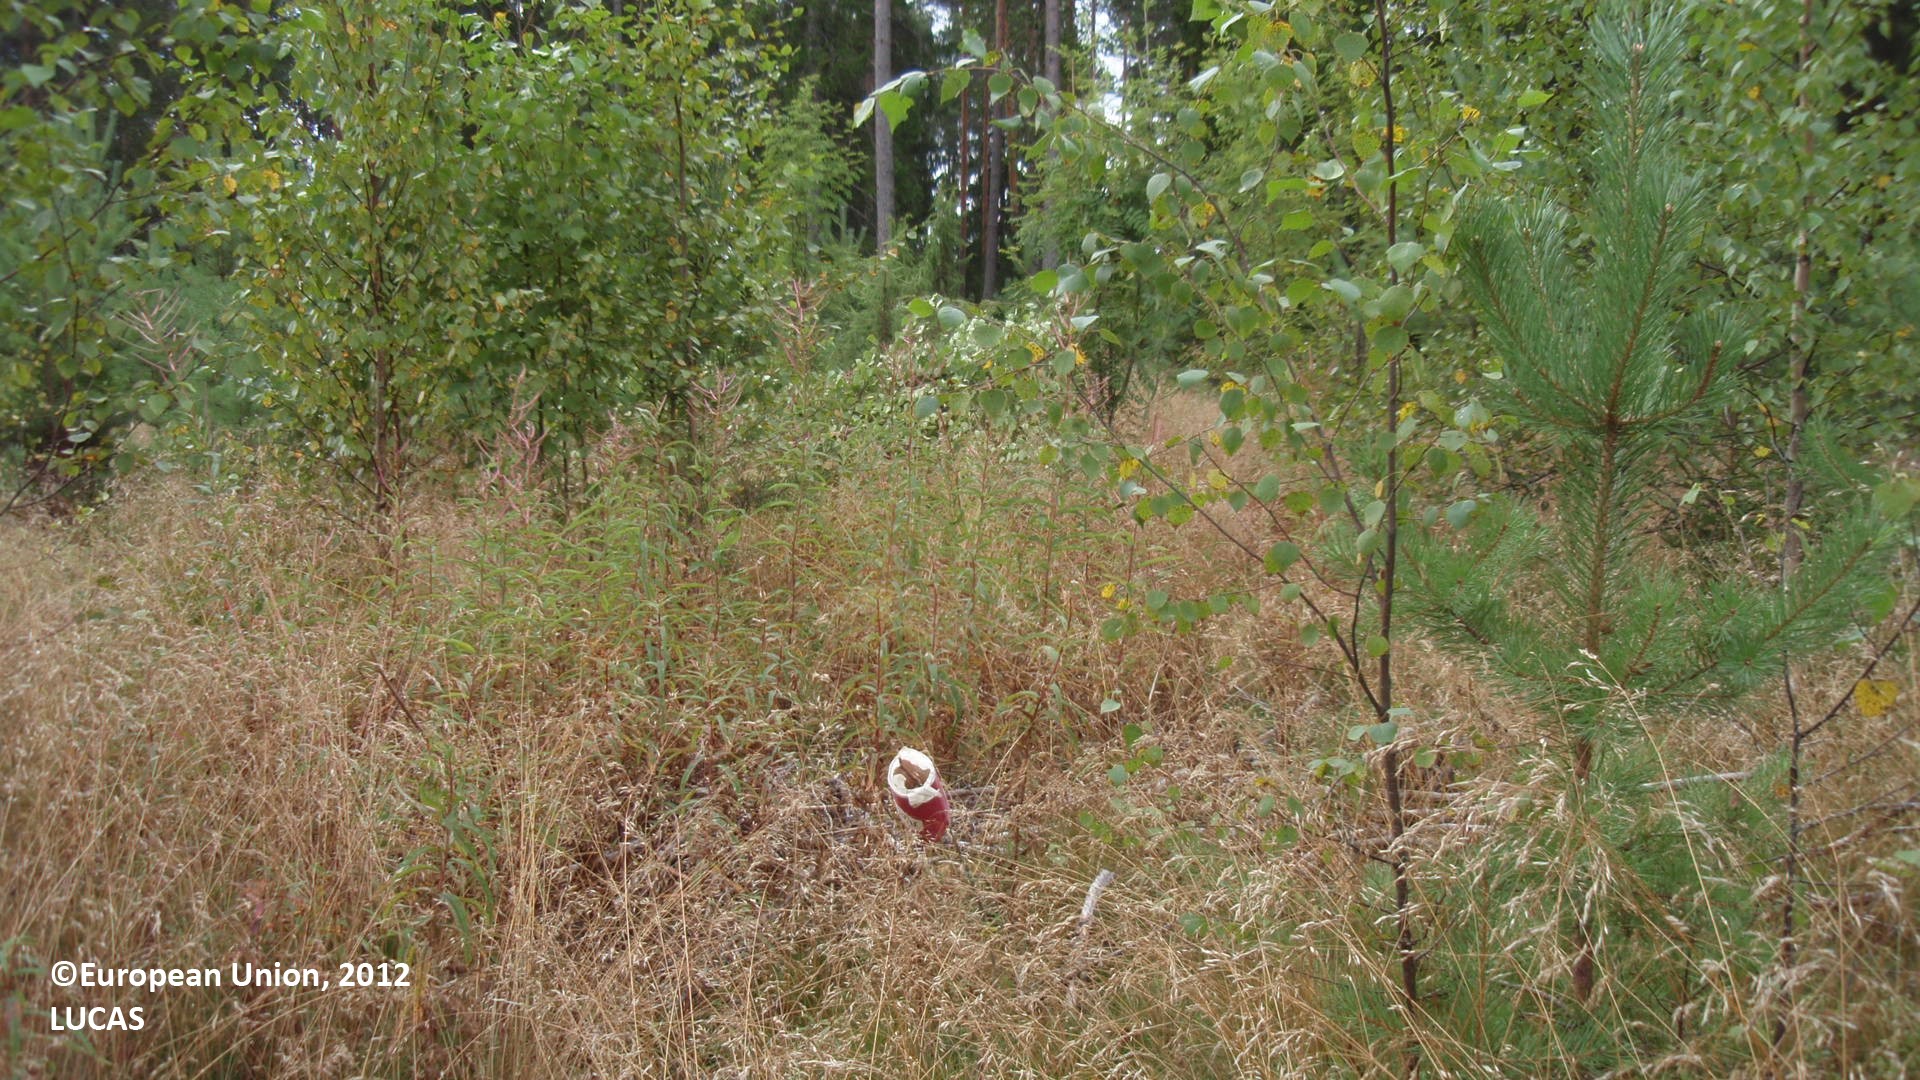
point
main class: Grassland
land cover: Grassland with sparse tree/shrub cover
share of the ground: 25 - 50 %
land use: Forestry
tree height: < 5 m
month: August
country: FI
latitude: 61.0853
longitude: 27.4025
